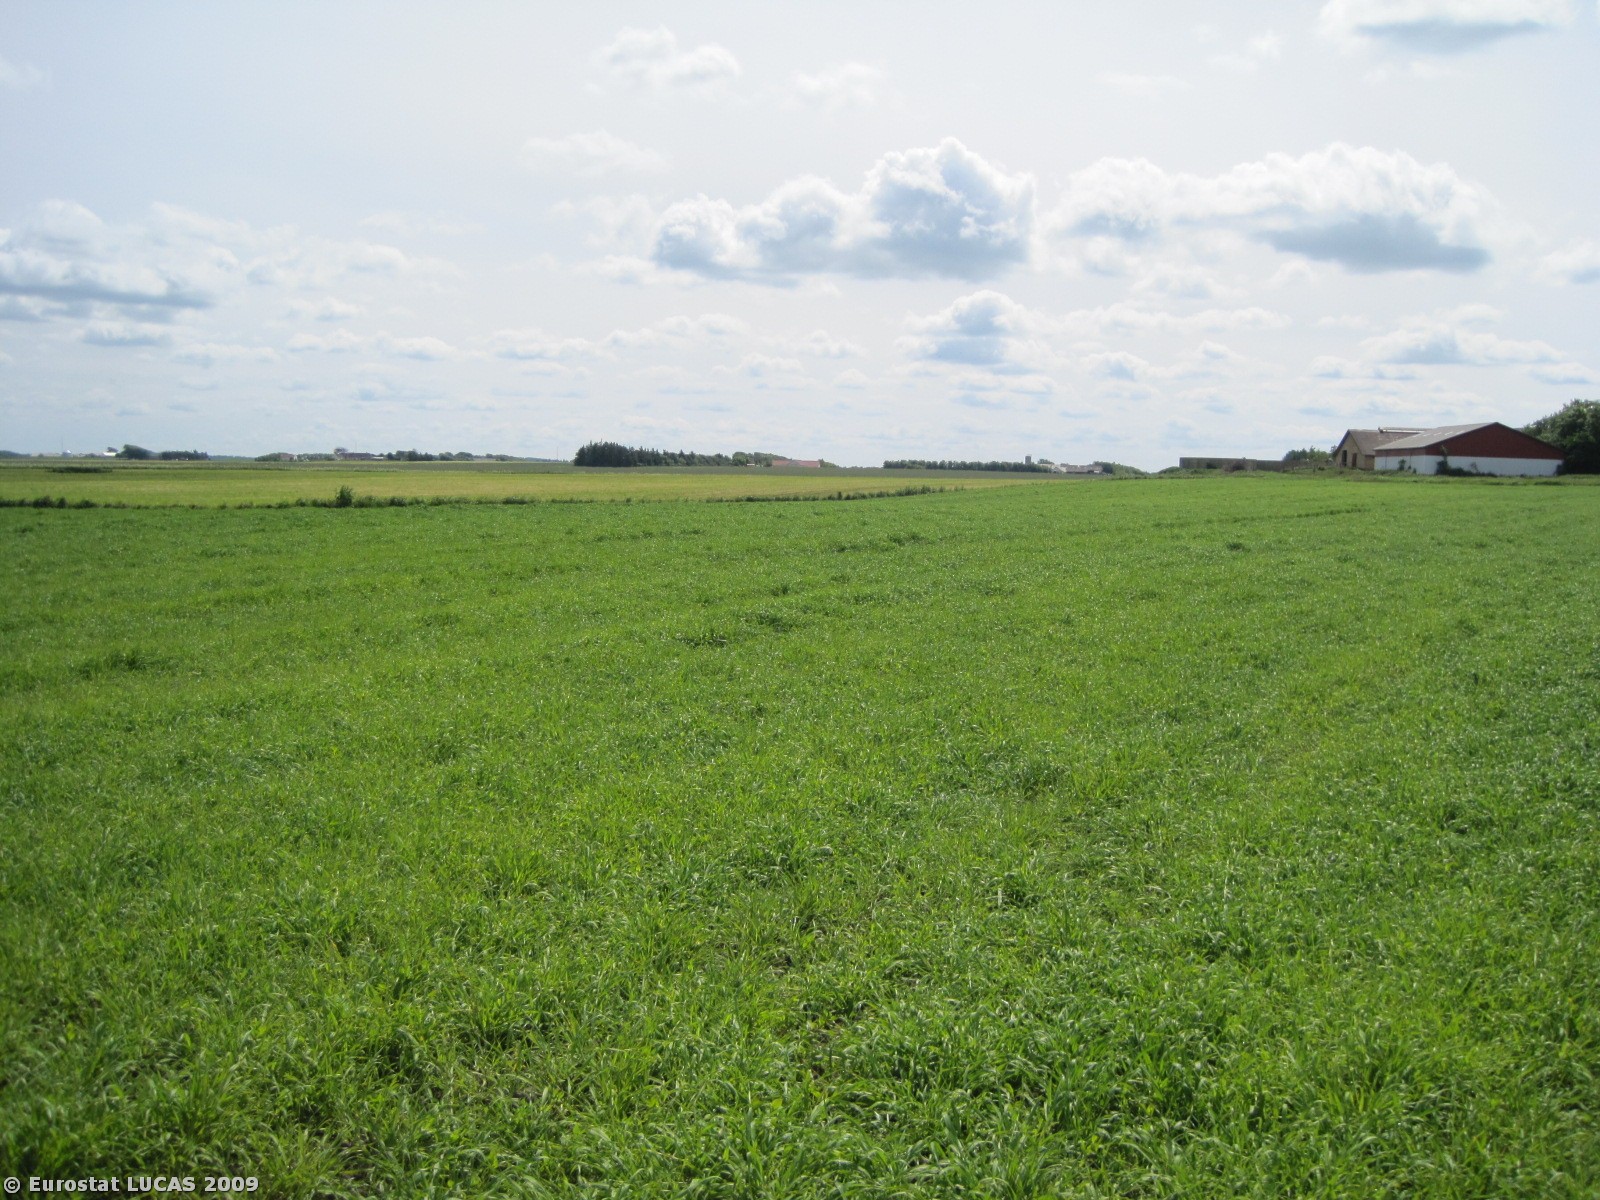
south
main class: Cropland
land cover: Barley
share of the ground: > 75 %
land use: Agriculture (excluding fallow land and kitchen gardens)
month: June
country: DK
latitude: 57.3561
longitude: 9.7843
